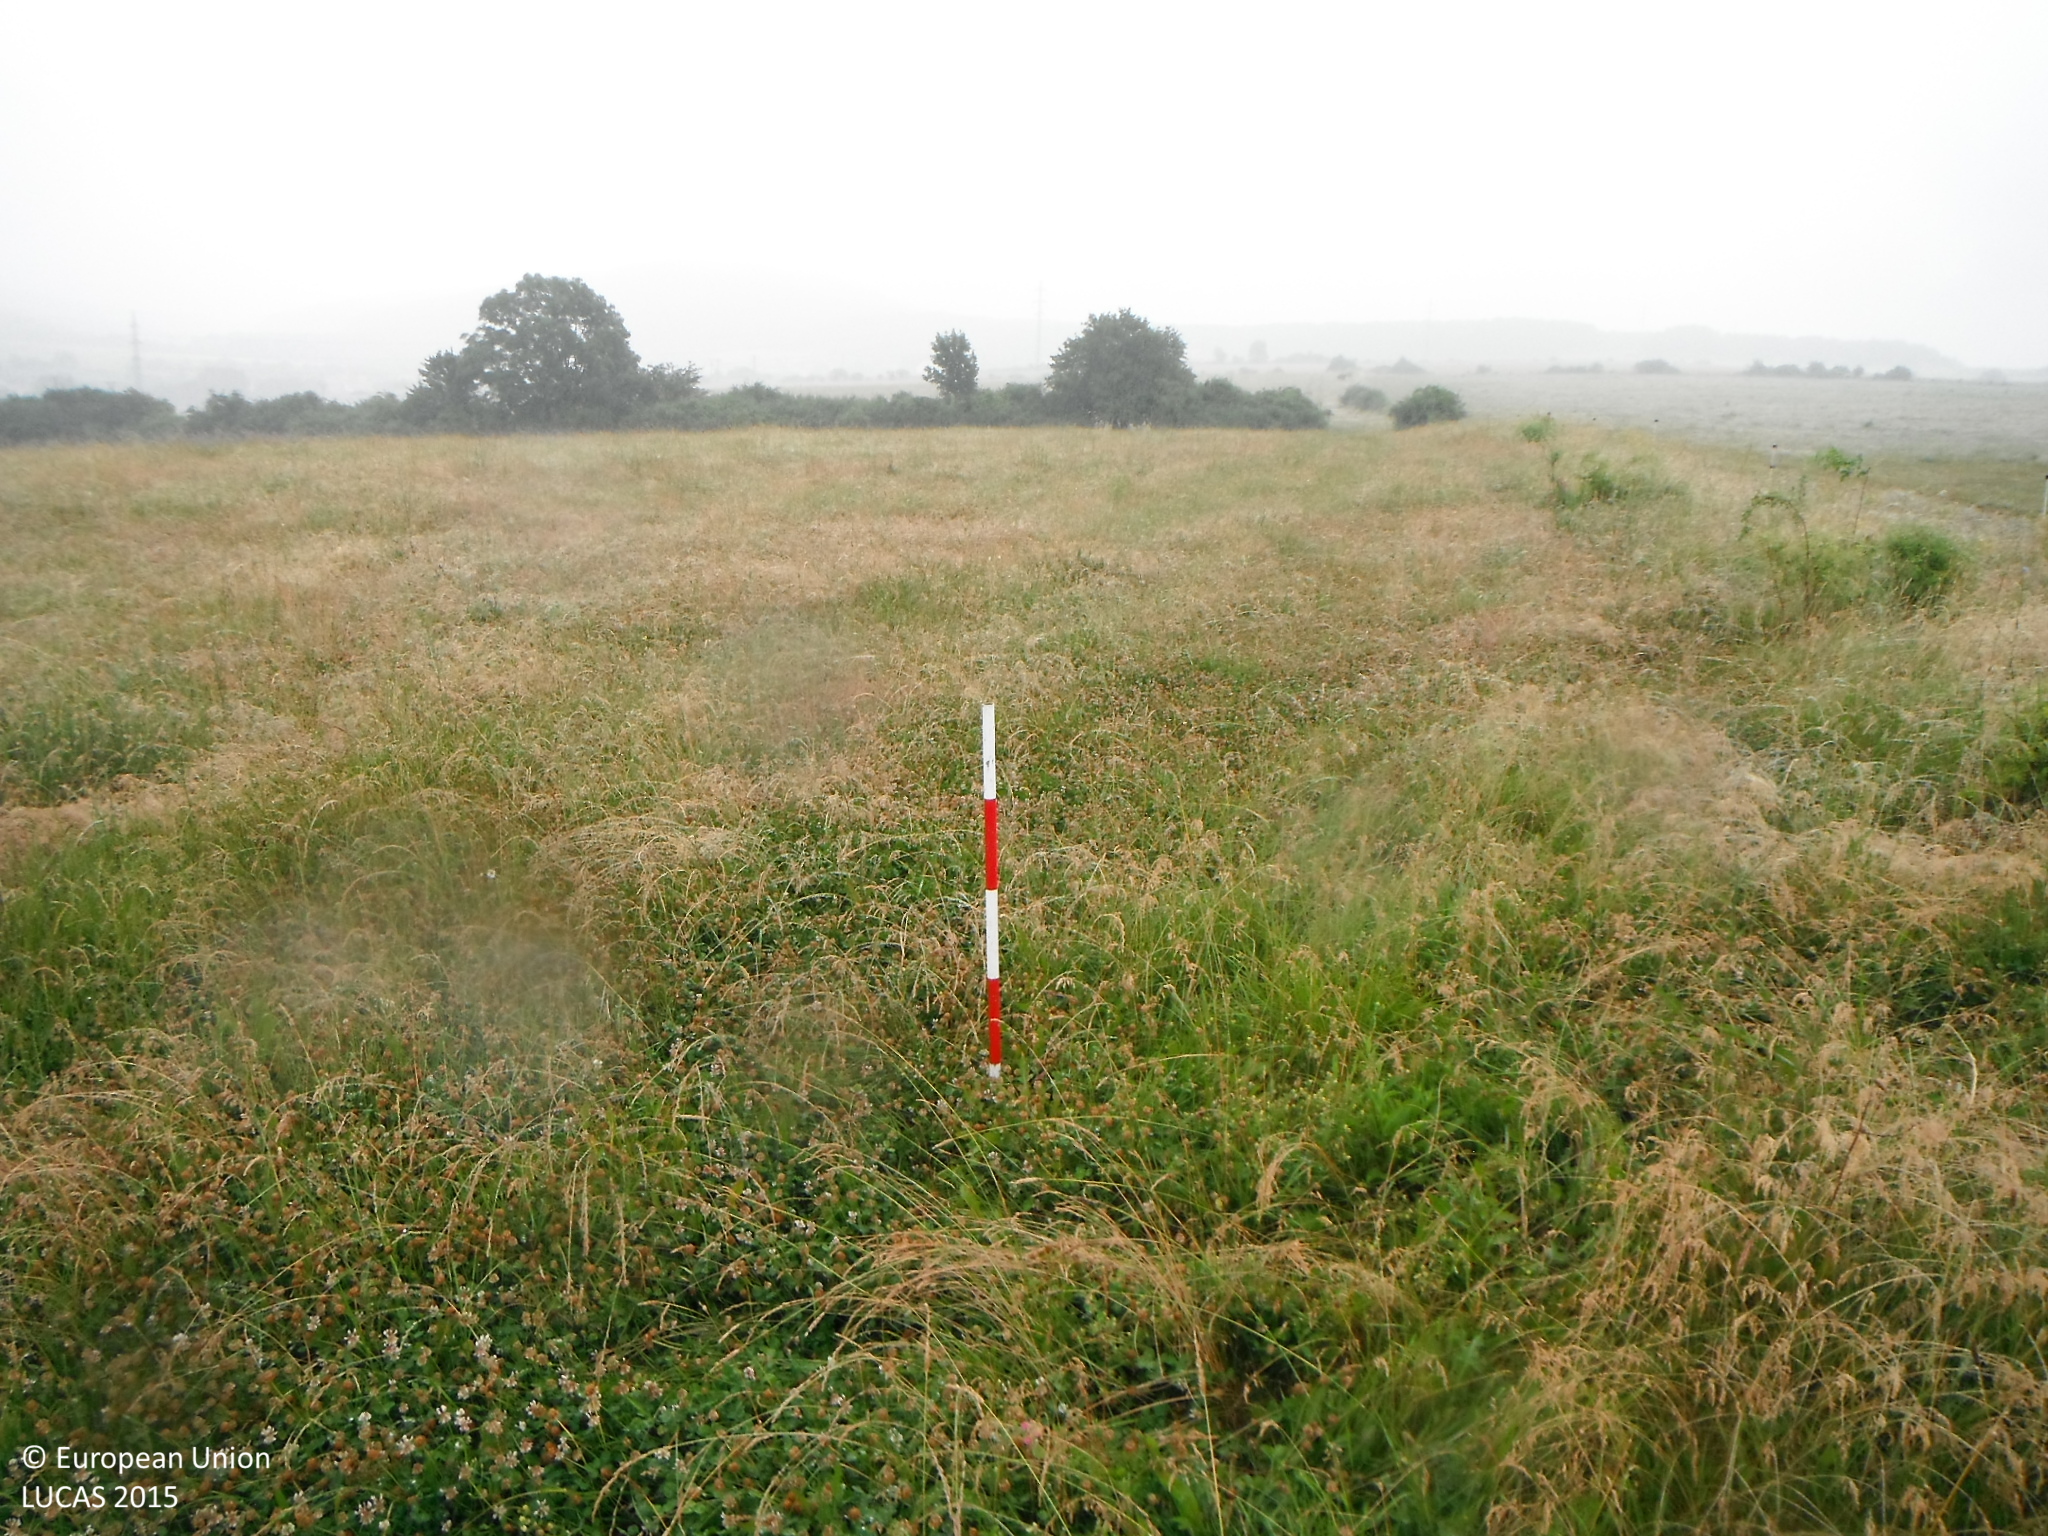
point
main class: Grassland
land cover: Grassland without tree/shrub cover
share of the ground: > 75 %
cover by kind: herbaceous plants 100 %
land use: Agriculture (excluding fallow land and kitchen gardens)
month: June
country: SK
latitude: 48.1235
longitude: 19.0345
